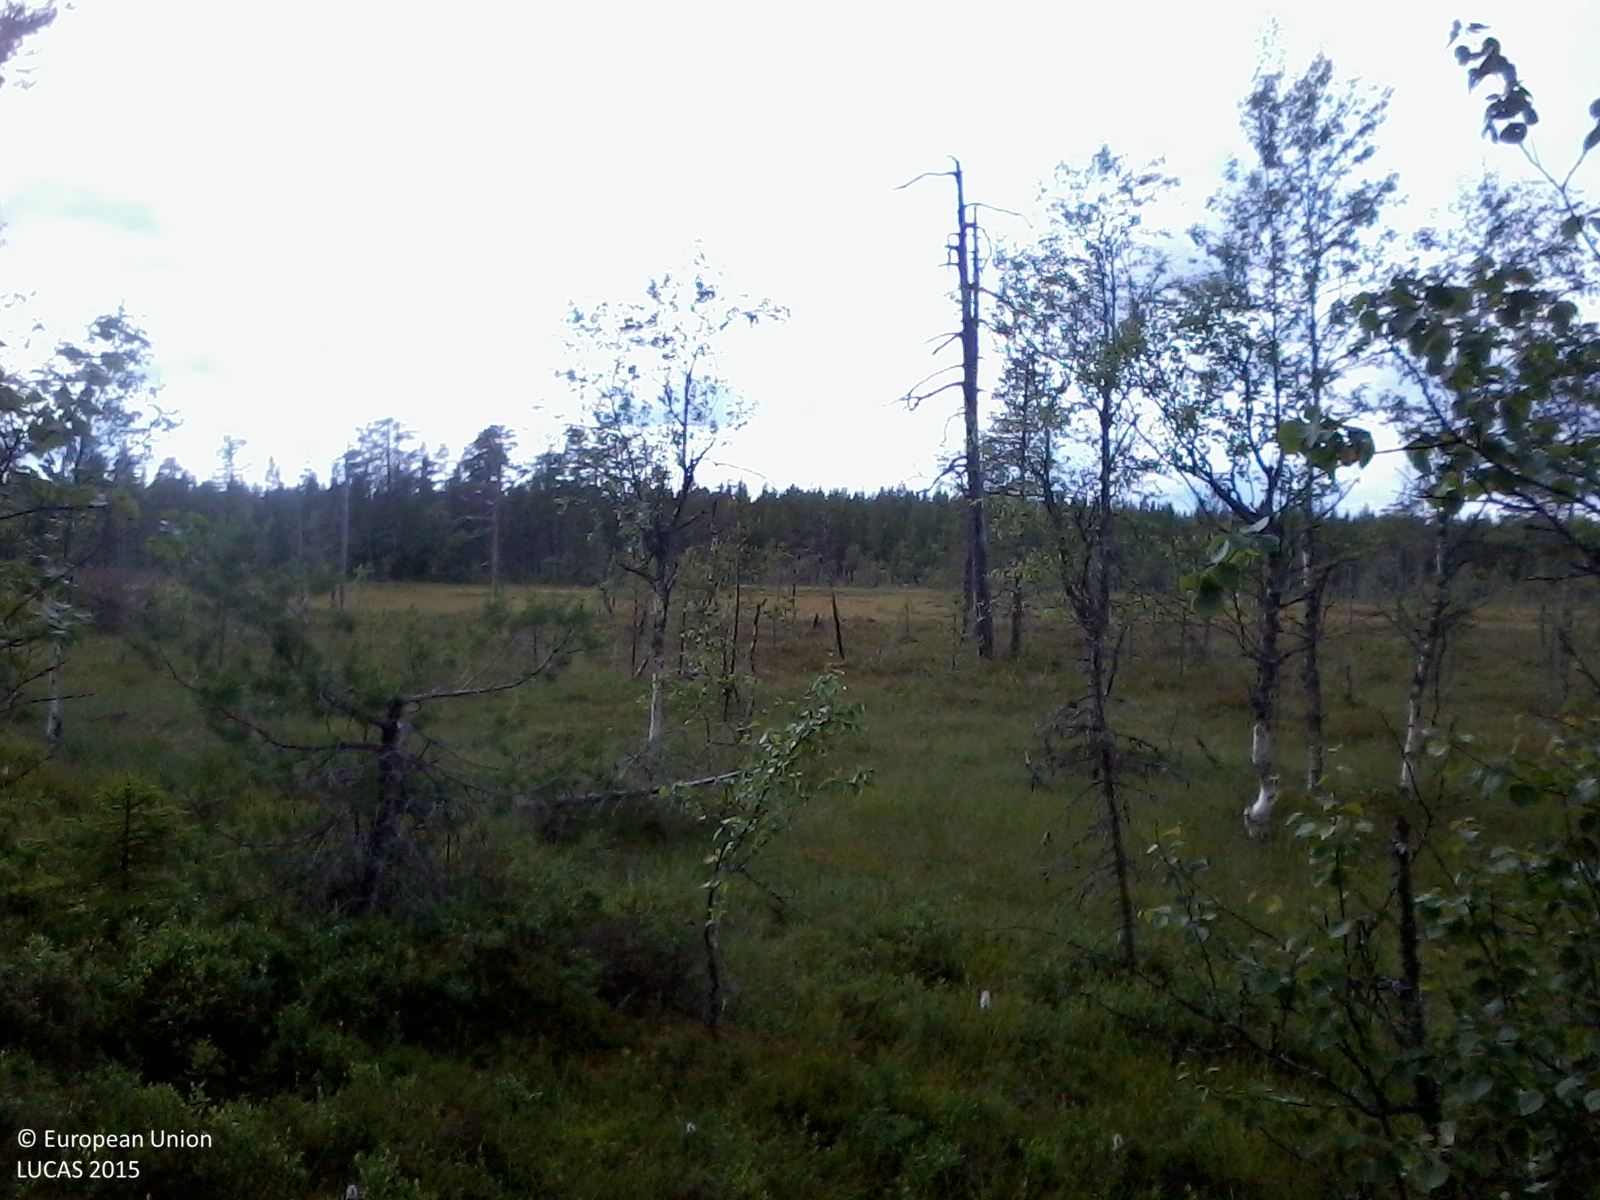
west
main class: Woodland
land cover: Pine dominated mixed woodland
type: boreal forest
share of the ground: 25 - 50 %
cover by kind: shrubs 50 %, coniferous forest trees 20 %, lichens and mosses 20 %, broadleaved forest trees 10 %
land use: Semi-natural and natural areas not in use
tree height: > 5 m
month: July
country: SE
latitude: 62.7535
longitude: 17.0852
